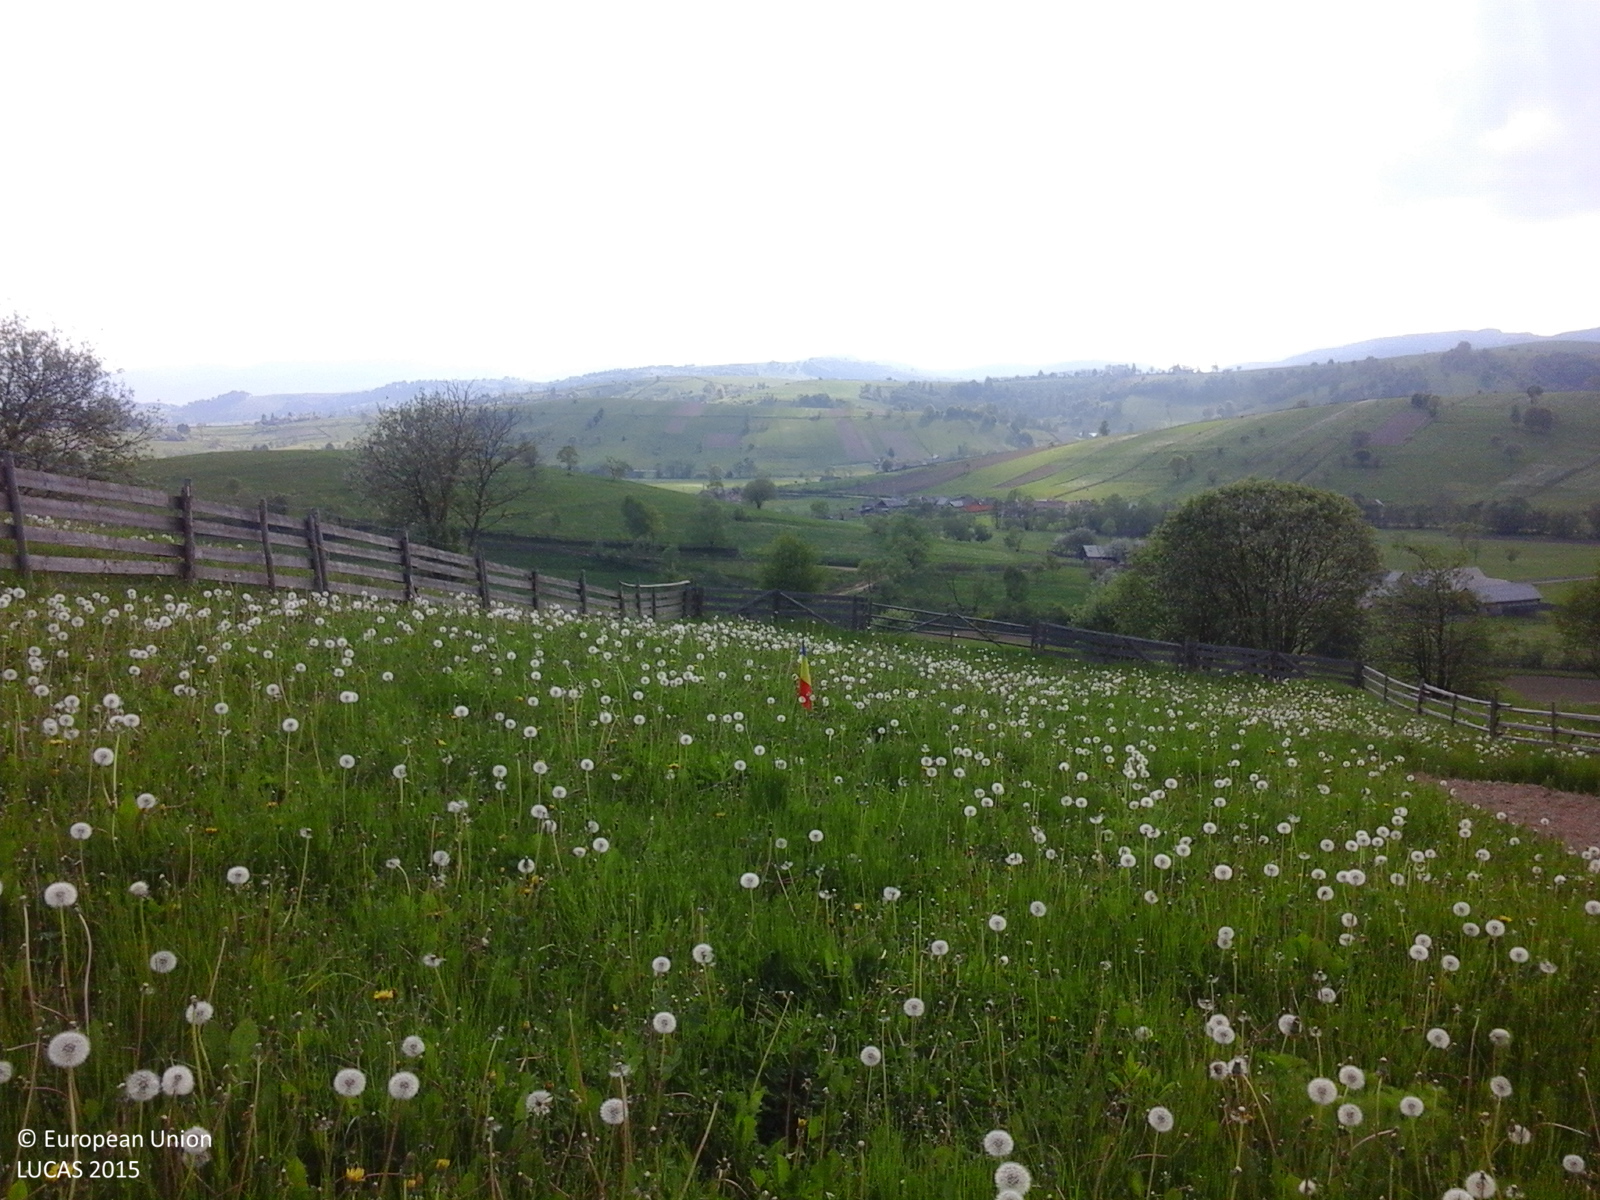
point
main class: Grassland
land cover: Grassland without tree/shrub cover
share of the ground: > 75 %
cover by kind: herbaceous plants 100 %
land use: Agriculture (excluding fallow land and kitchen gardens)
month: May
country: RO
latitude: 45.7111
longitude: 26.0840
